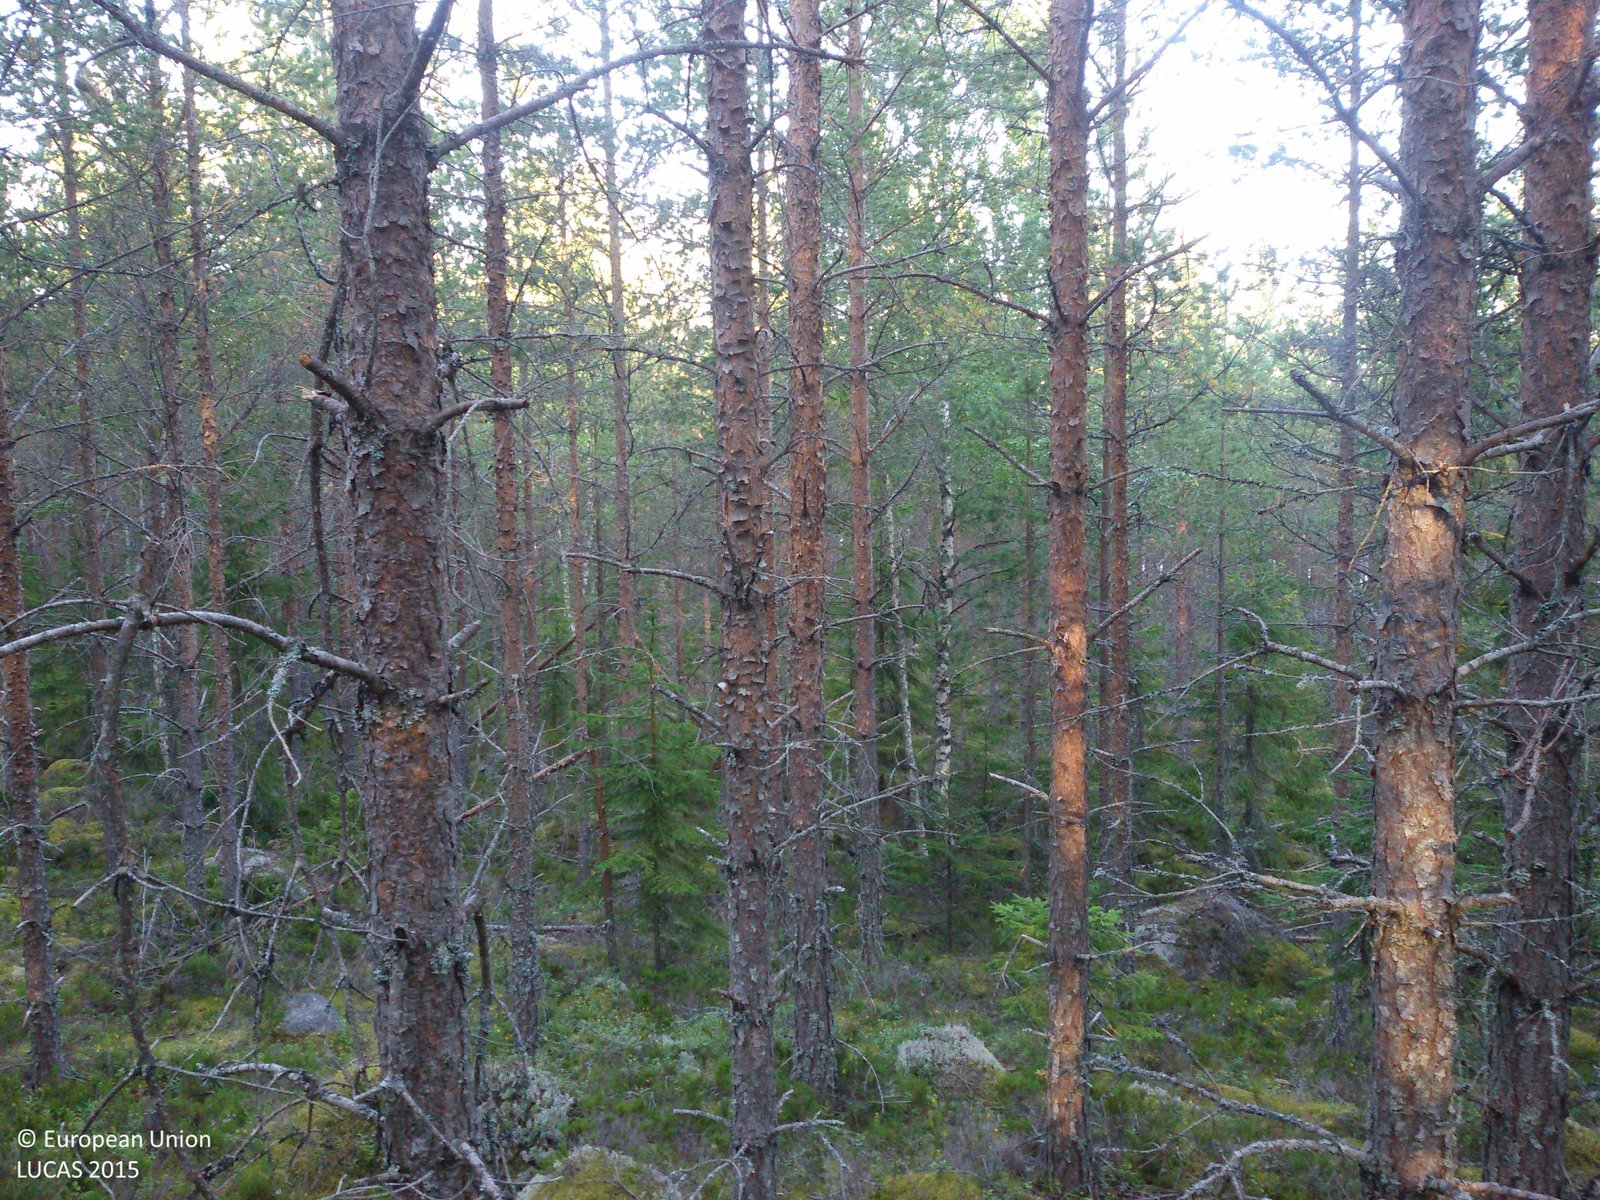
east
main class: Woodland
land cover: Pine dominated coniferous woodland
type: boreal forest
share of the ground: > 75 %
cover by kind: coniferous forest trees 90 %, shrubs 5 %, lichens and mosses 5 %
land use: Forestry
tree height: > 5 m
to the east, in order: Pine dominated coniferous woodland; Pine dominated mixed woodland; Inland fresh water bodies
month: August
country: SE
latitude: 60.8791
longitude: 16.5264
